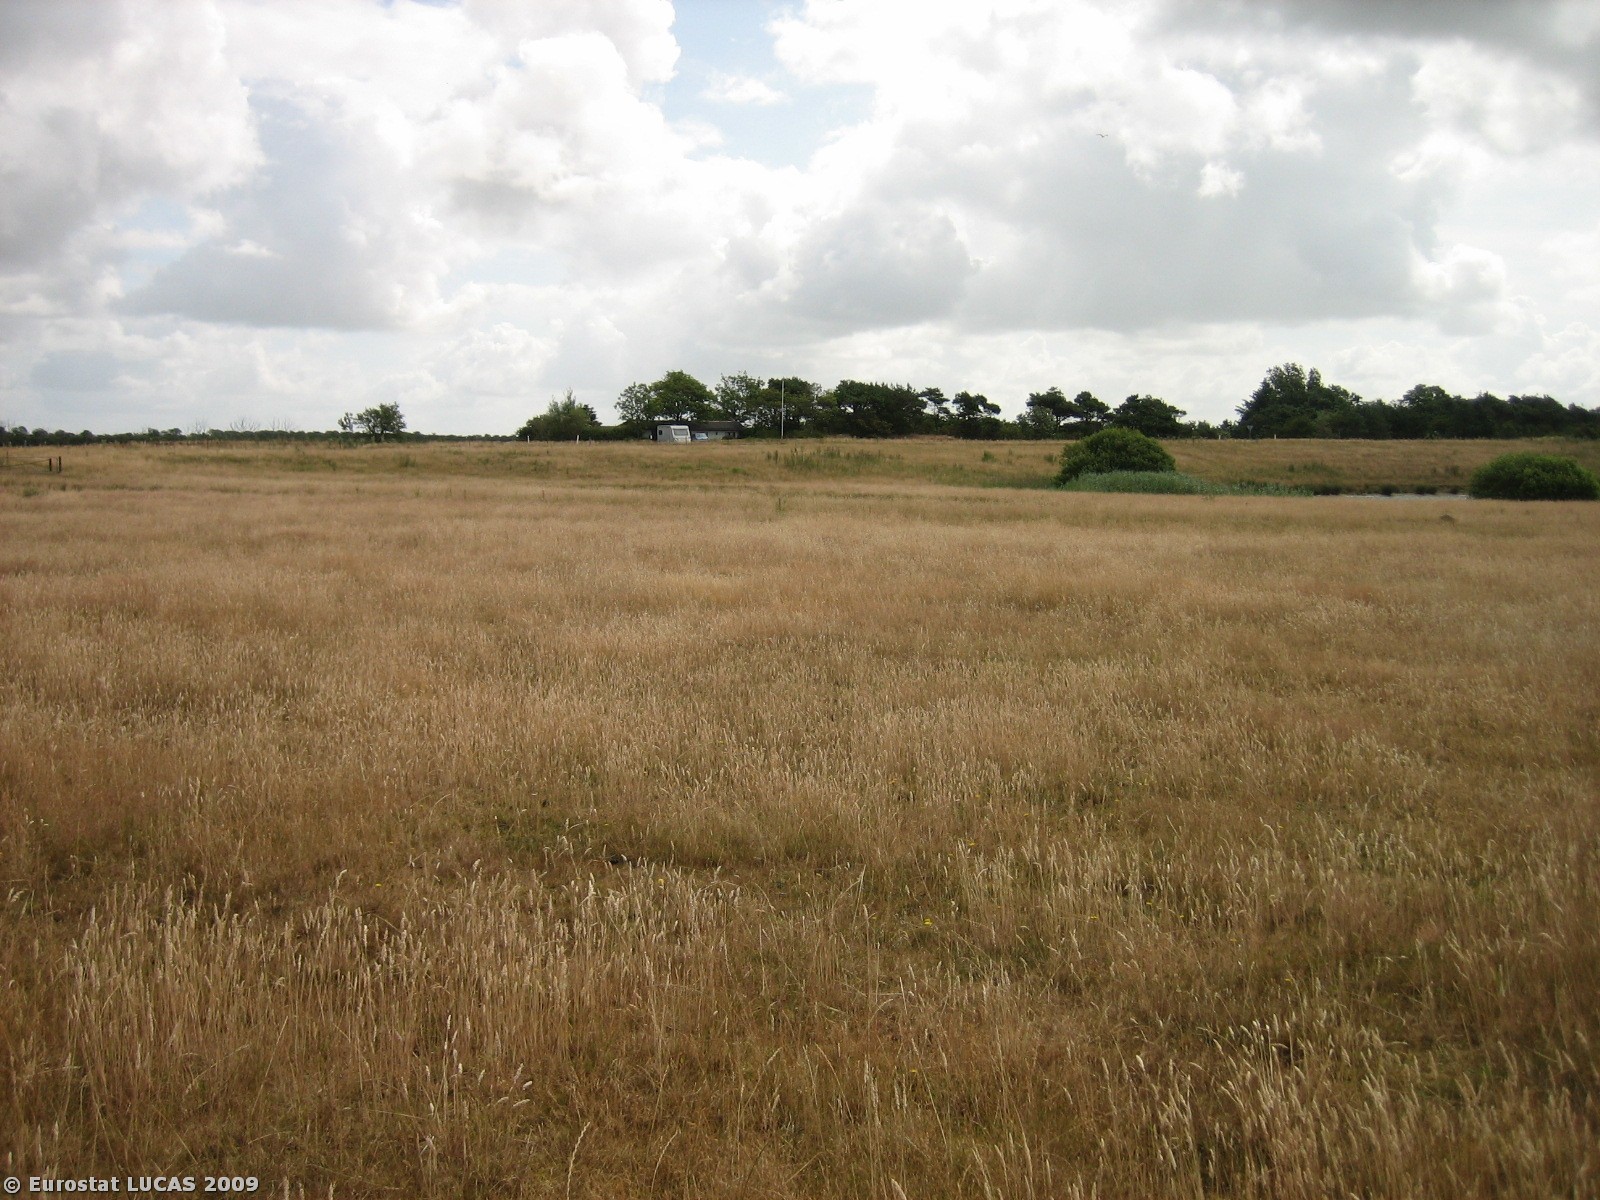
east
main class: Grassland
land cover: Grassland without tree/shrub cover
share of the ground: > 75 %
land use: Agriculture (excluding fallow land and kitchen gardens)
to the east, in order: Grassland without tree/shrub cover; Tracks; Grassland without tree/shrub cover; Fences; Grass margins; Ditches and canals; Grass margins; Paved roads, cycling and walking lanes; Grass margins; Broadleaved woodland; Artificial constructions in urban areas; Grassland without tree/shrub cover; Managed hedges; Fences; Grassland without tree/shrub cover
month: July
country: DK
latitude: 55.5661
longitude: 8.3681
